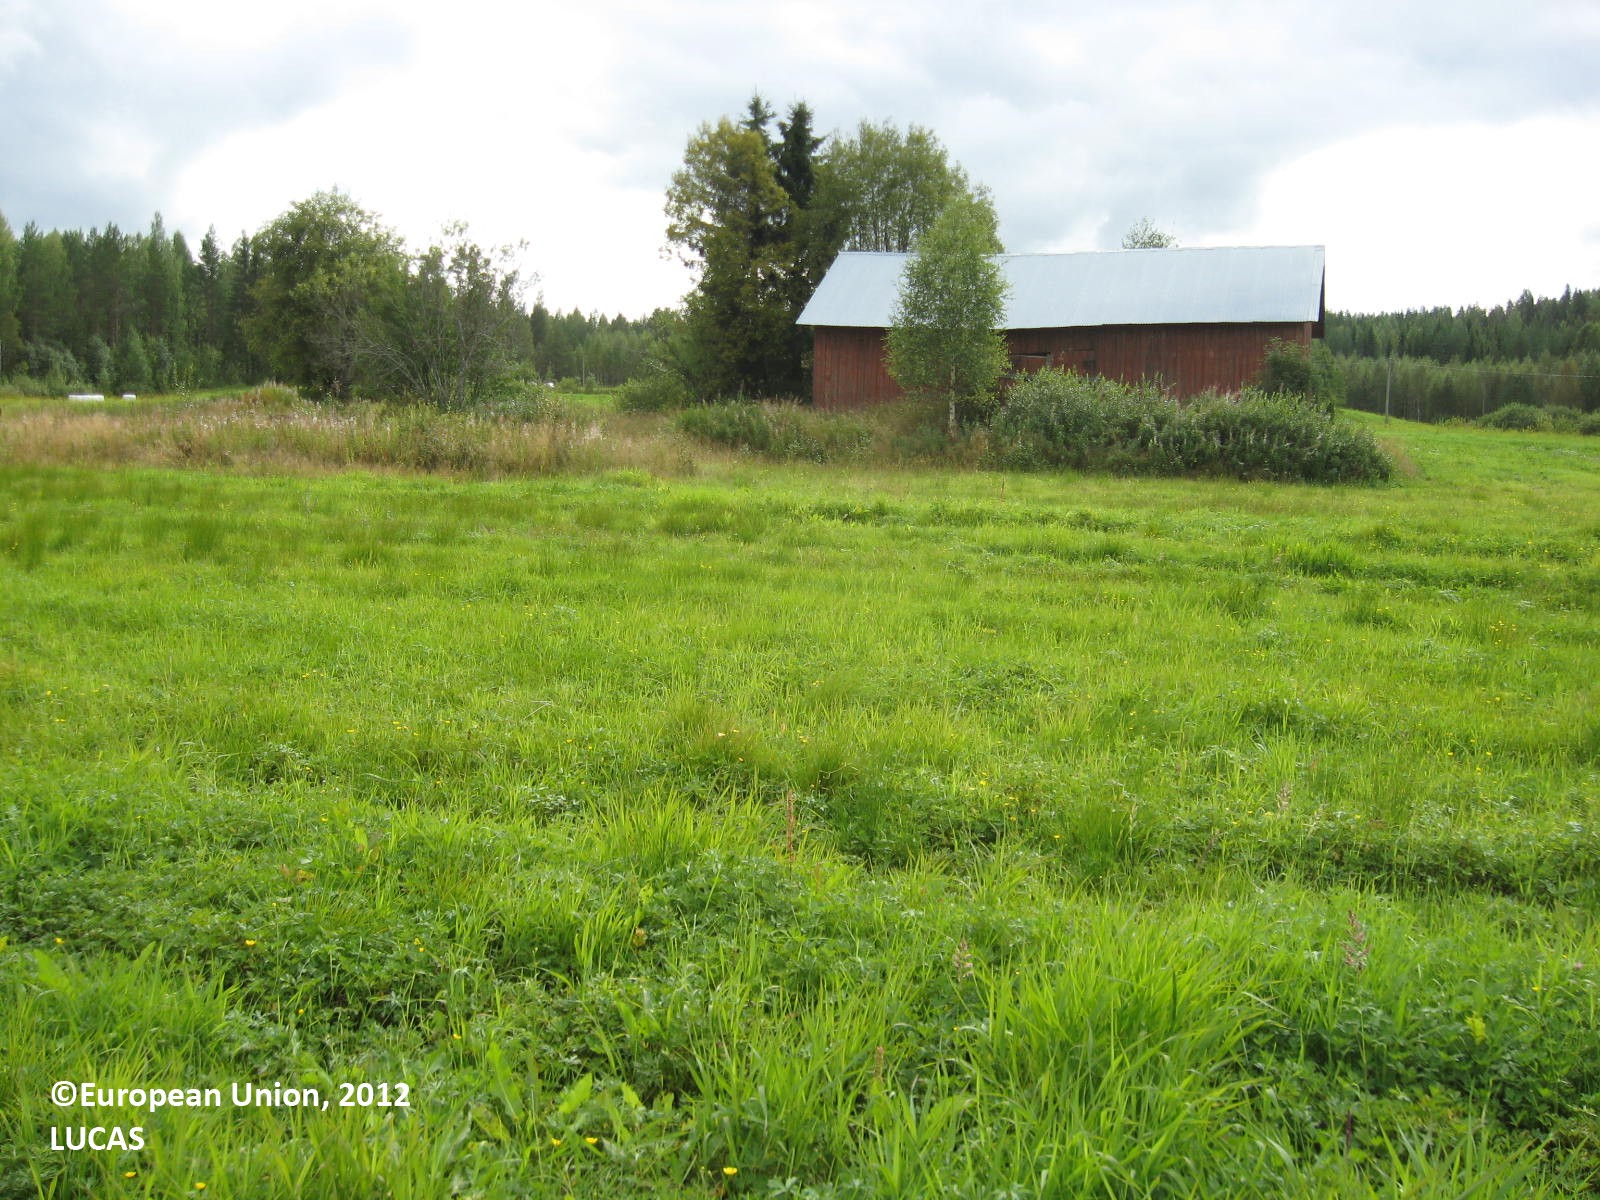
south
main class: Cropland
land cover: Temporary grasslands
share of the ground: > 75 %
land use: Agriculture (excluding fallow land and kitchen gardens)
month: August
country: FI
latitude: 63.5917
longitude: 29.2605
